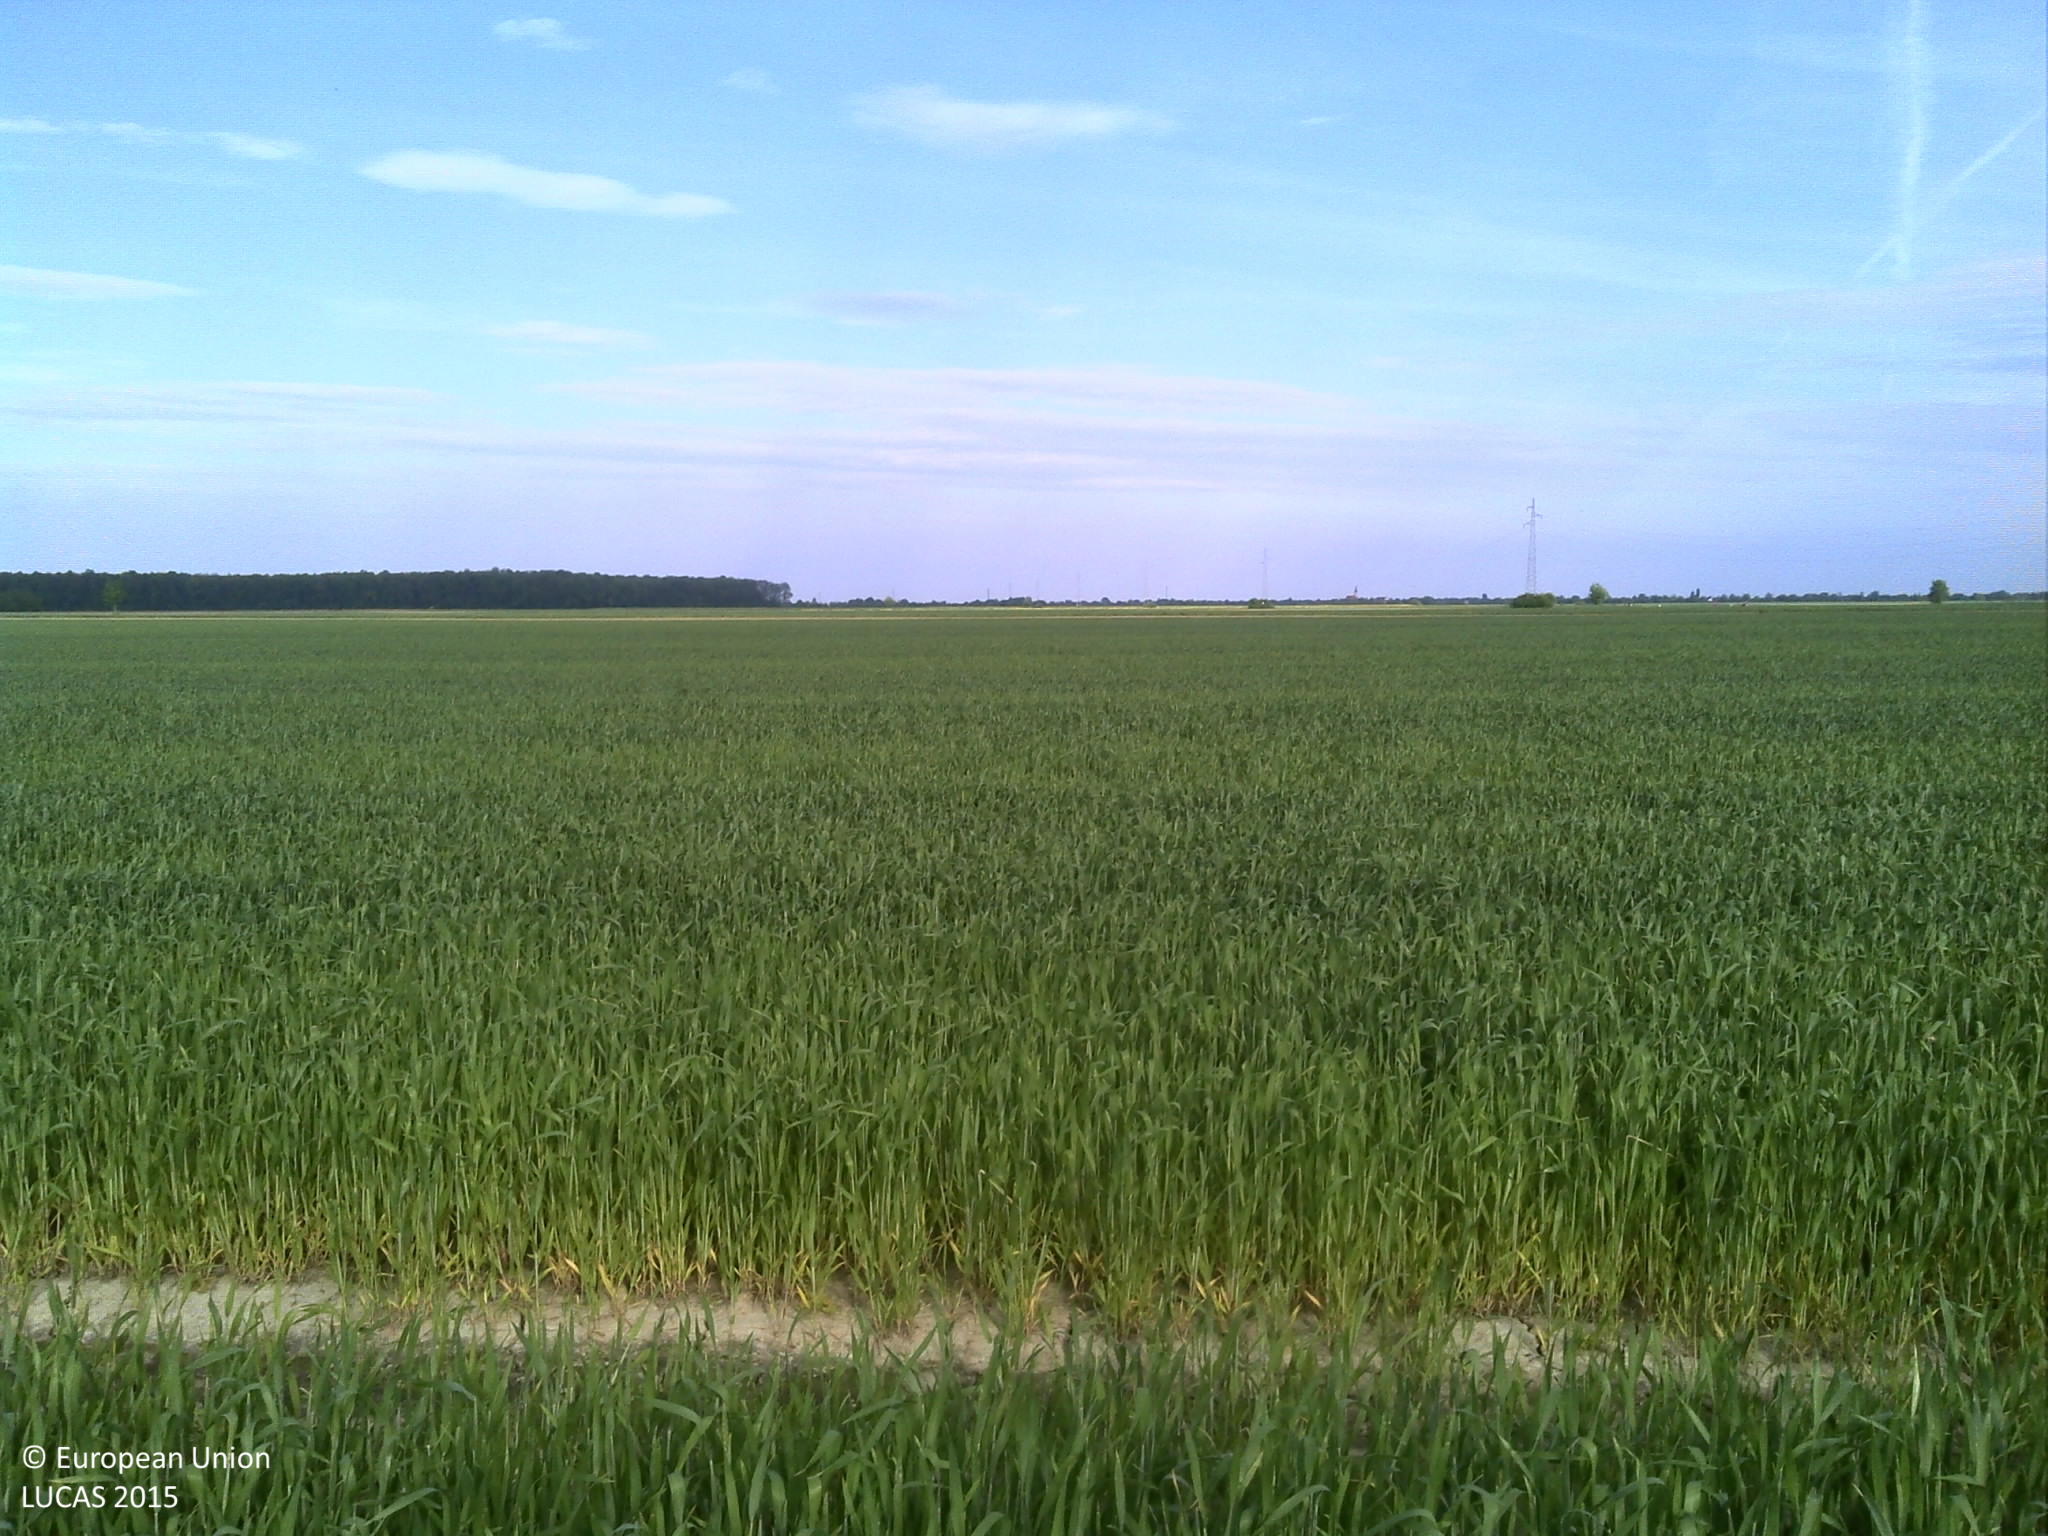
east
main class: Cropland
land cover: Common wheat
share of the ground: > 75 %
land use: Agriculture (excluding fallow land and kitchen gardens)
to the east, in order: Common wheat; Soya
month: May
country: HR
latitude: 45.1642
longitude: 18.9001
